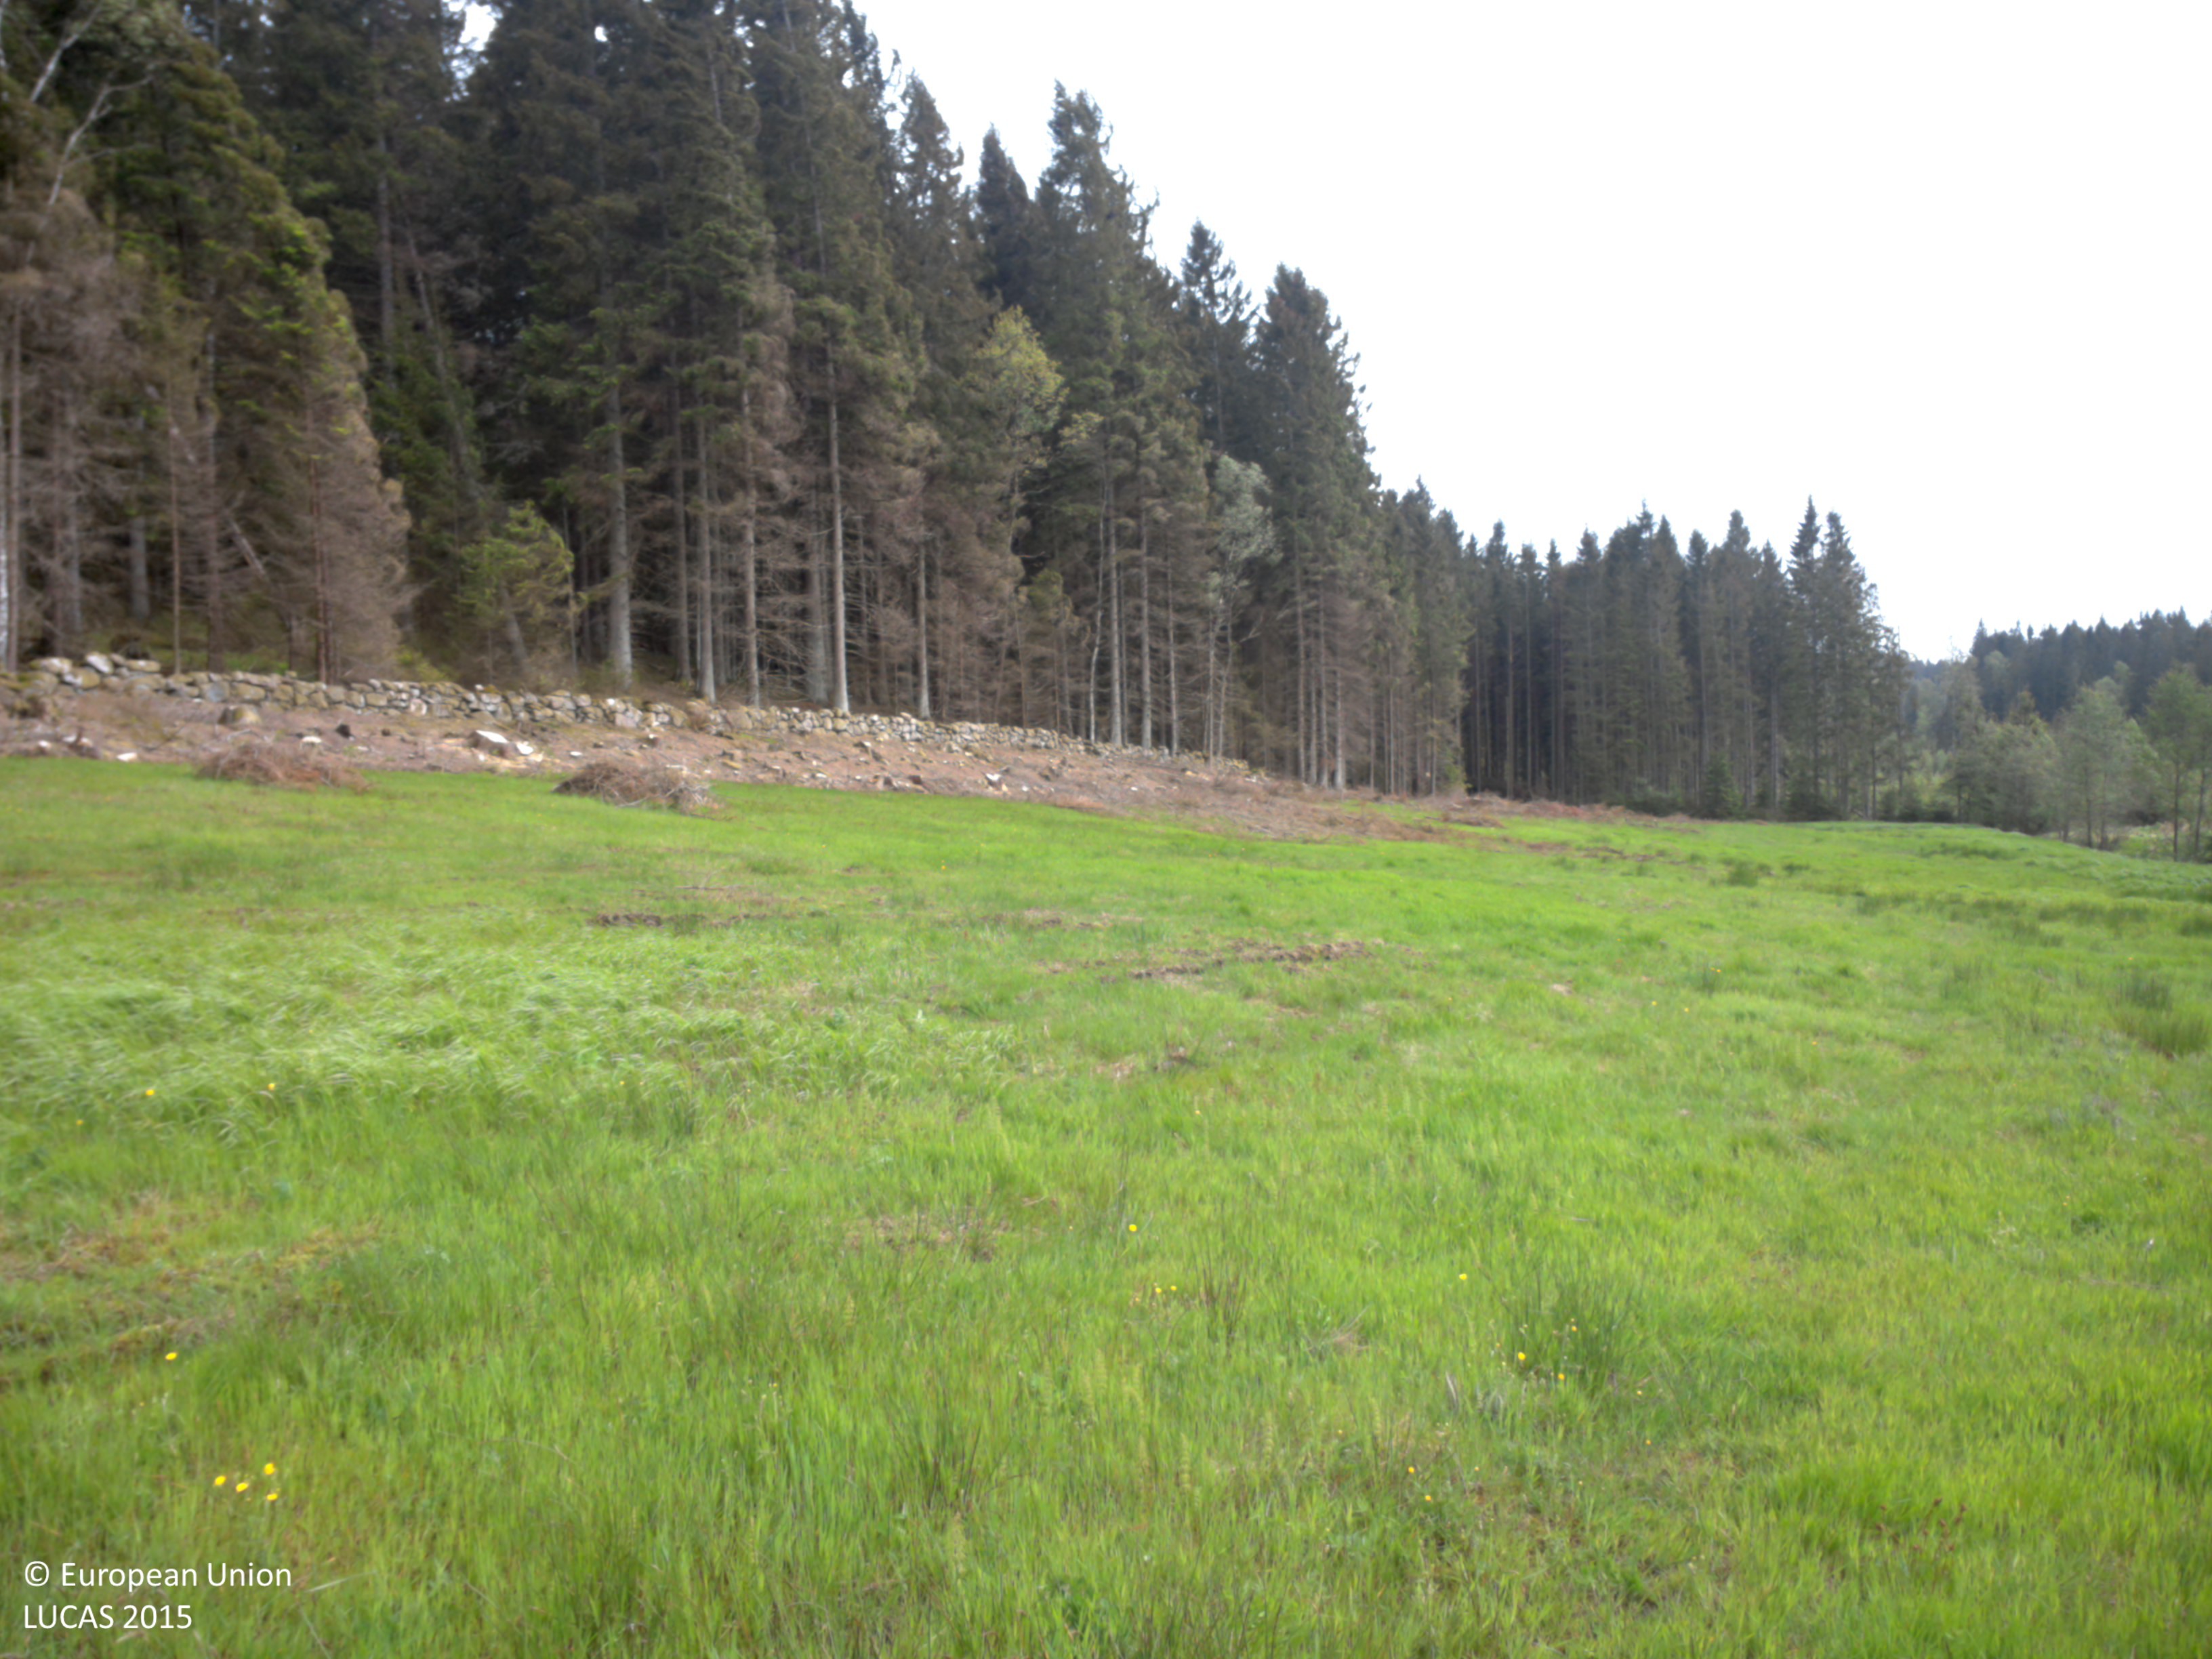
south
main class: Grassland
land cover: Grassland without tree/shrub cover
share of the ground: > 75 %
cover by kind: herbaceous plants 100 %
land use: Agriculture (excluding fallow land and kitchen gardens)
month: June
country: SE
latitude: 58.1693
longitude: 11.9512
